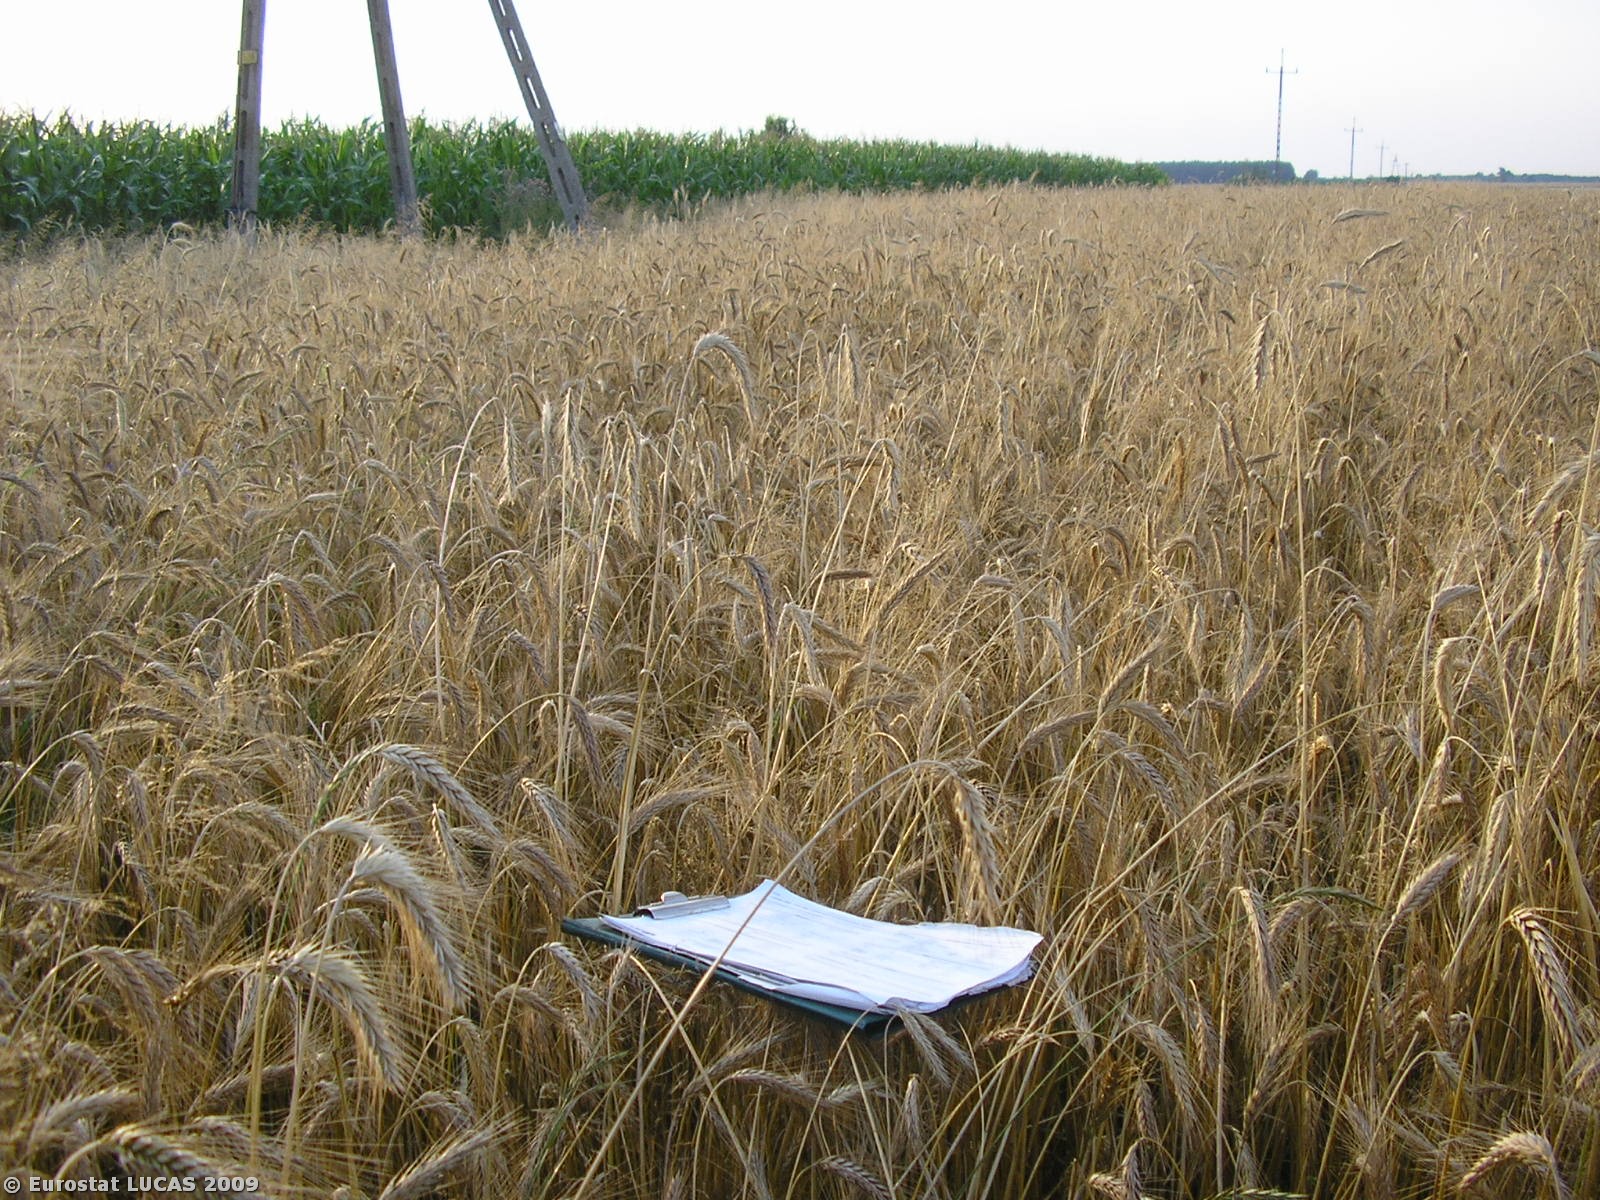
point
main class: Cropland
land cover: Rye
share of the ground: > 75 %
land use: Agriculture (excluding fallow land and kitchen gardens)
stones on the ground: < 10 %
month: July
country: PL
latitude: 52.1303
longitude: 22.1714
